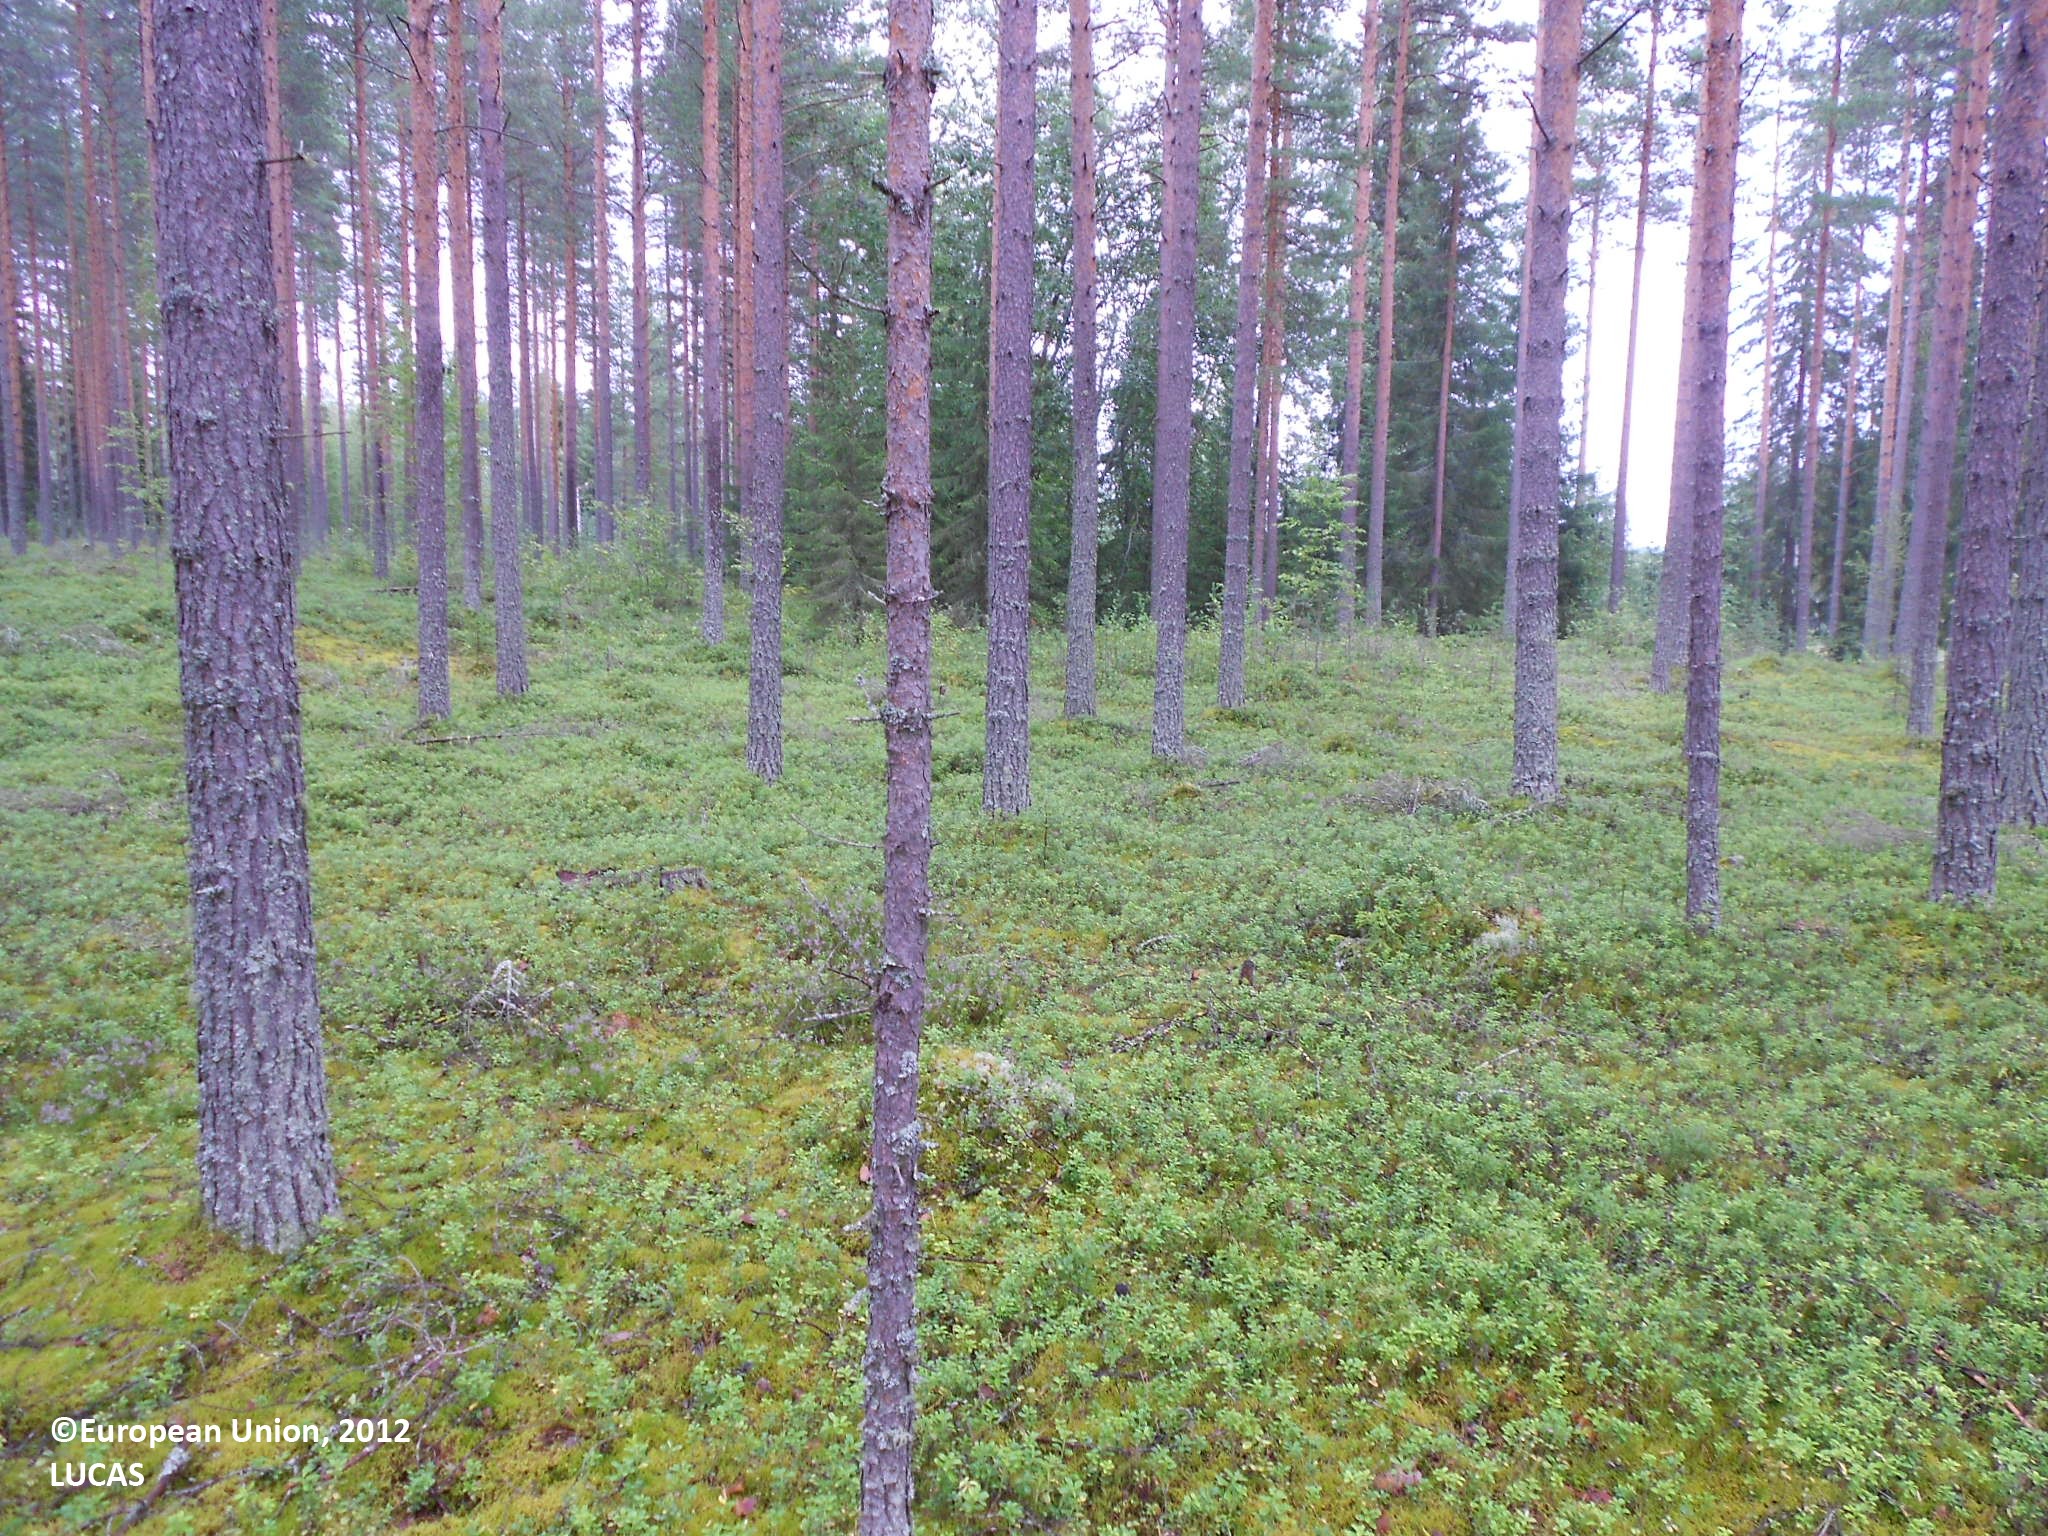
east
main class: Woodland
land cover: Pine dominated coniferous woodland
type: boreal forest
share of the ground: 50 - 75 %
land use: Forestry
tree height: > 5 m
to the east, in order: Pine dominated coniferous woodland; Grassland with sparse tree/shrub cover; Ditches and canals; Tracks; Ditches and canals; Pine dominated coniferous woodland
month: August
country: FI
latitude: 63.5788
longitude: 28.9166
